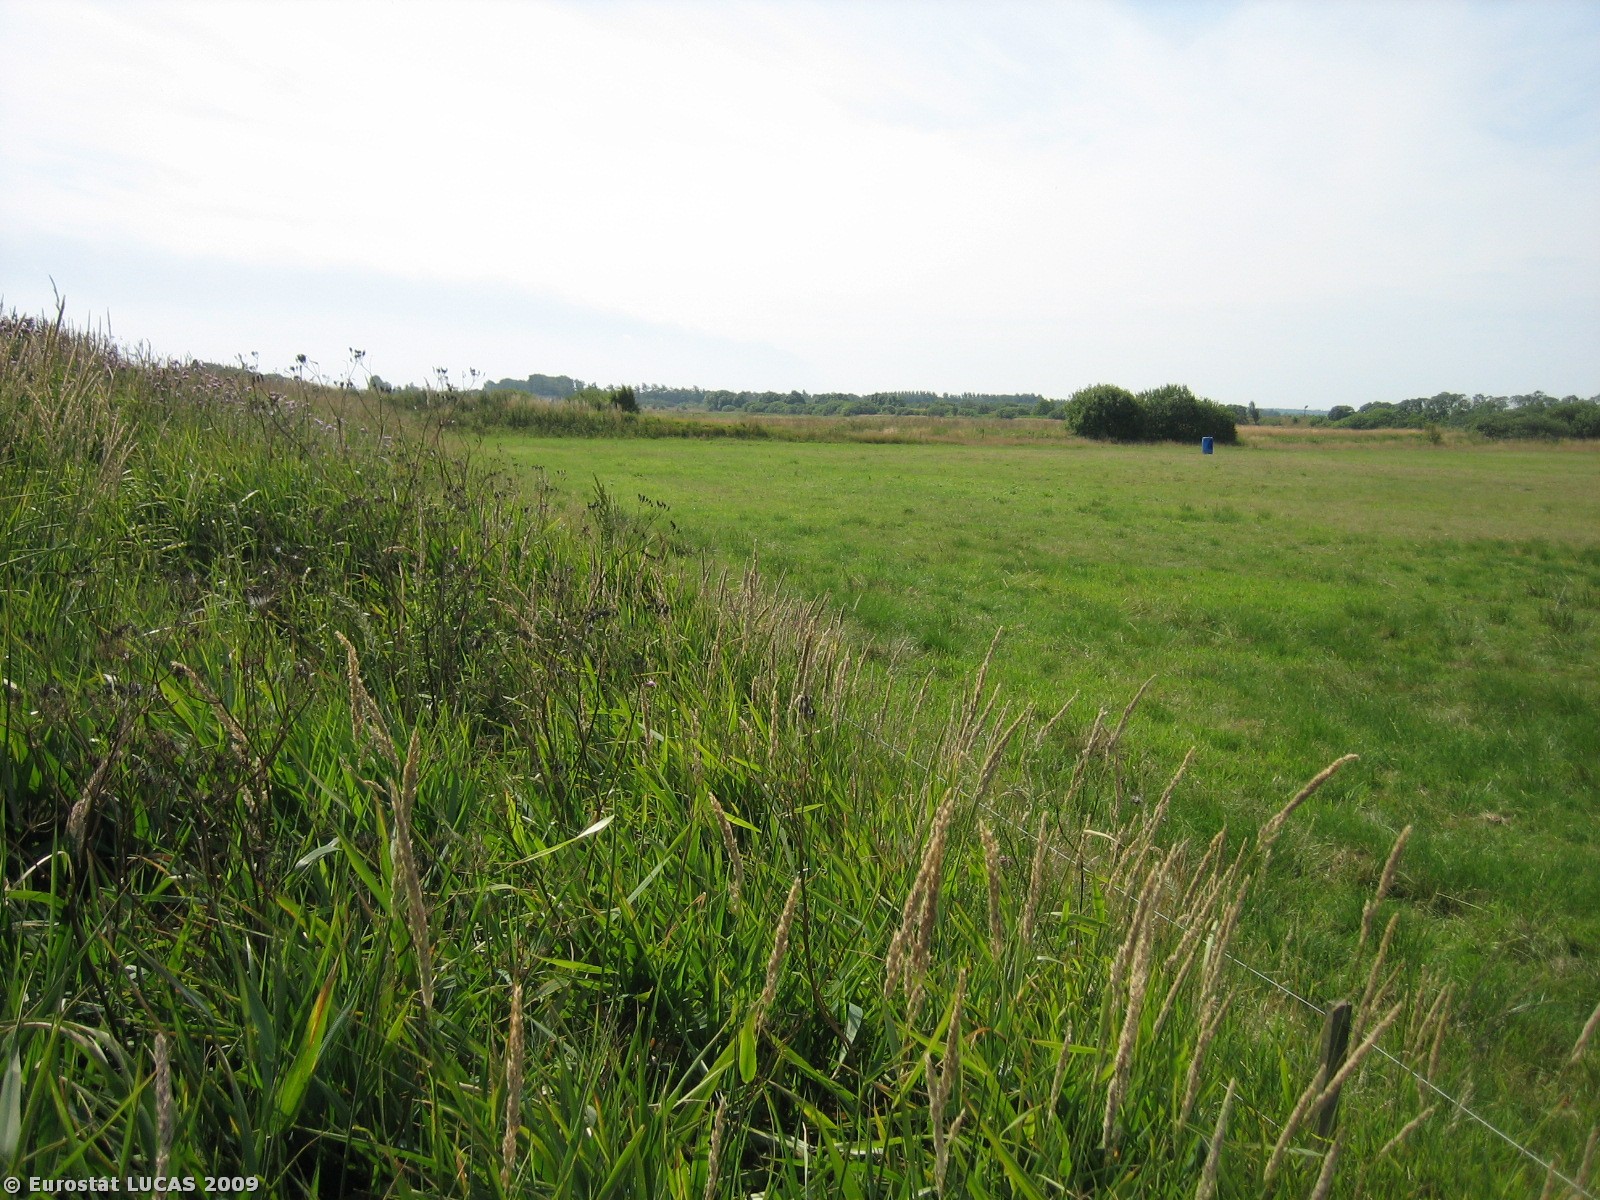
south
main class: Grassland
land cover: Grassland without tree/shrub cover
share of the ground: > 75 %
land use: Nature reserves
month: July
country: DK
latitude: 55.9274
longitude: 8.5131
